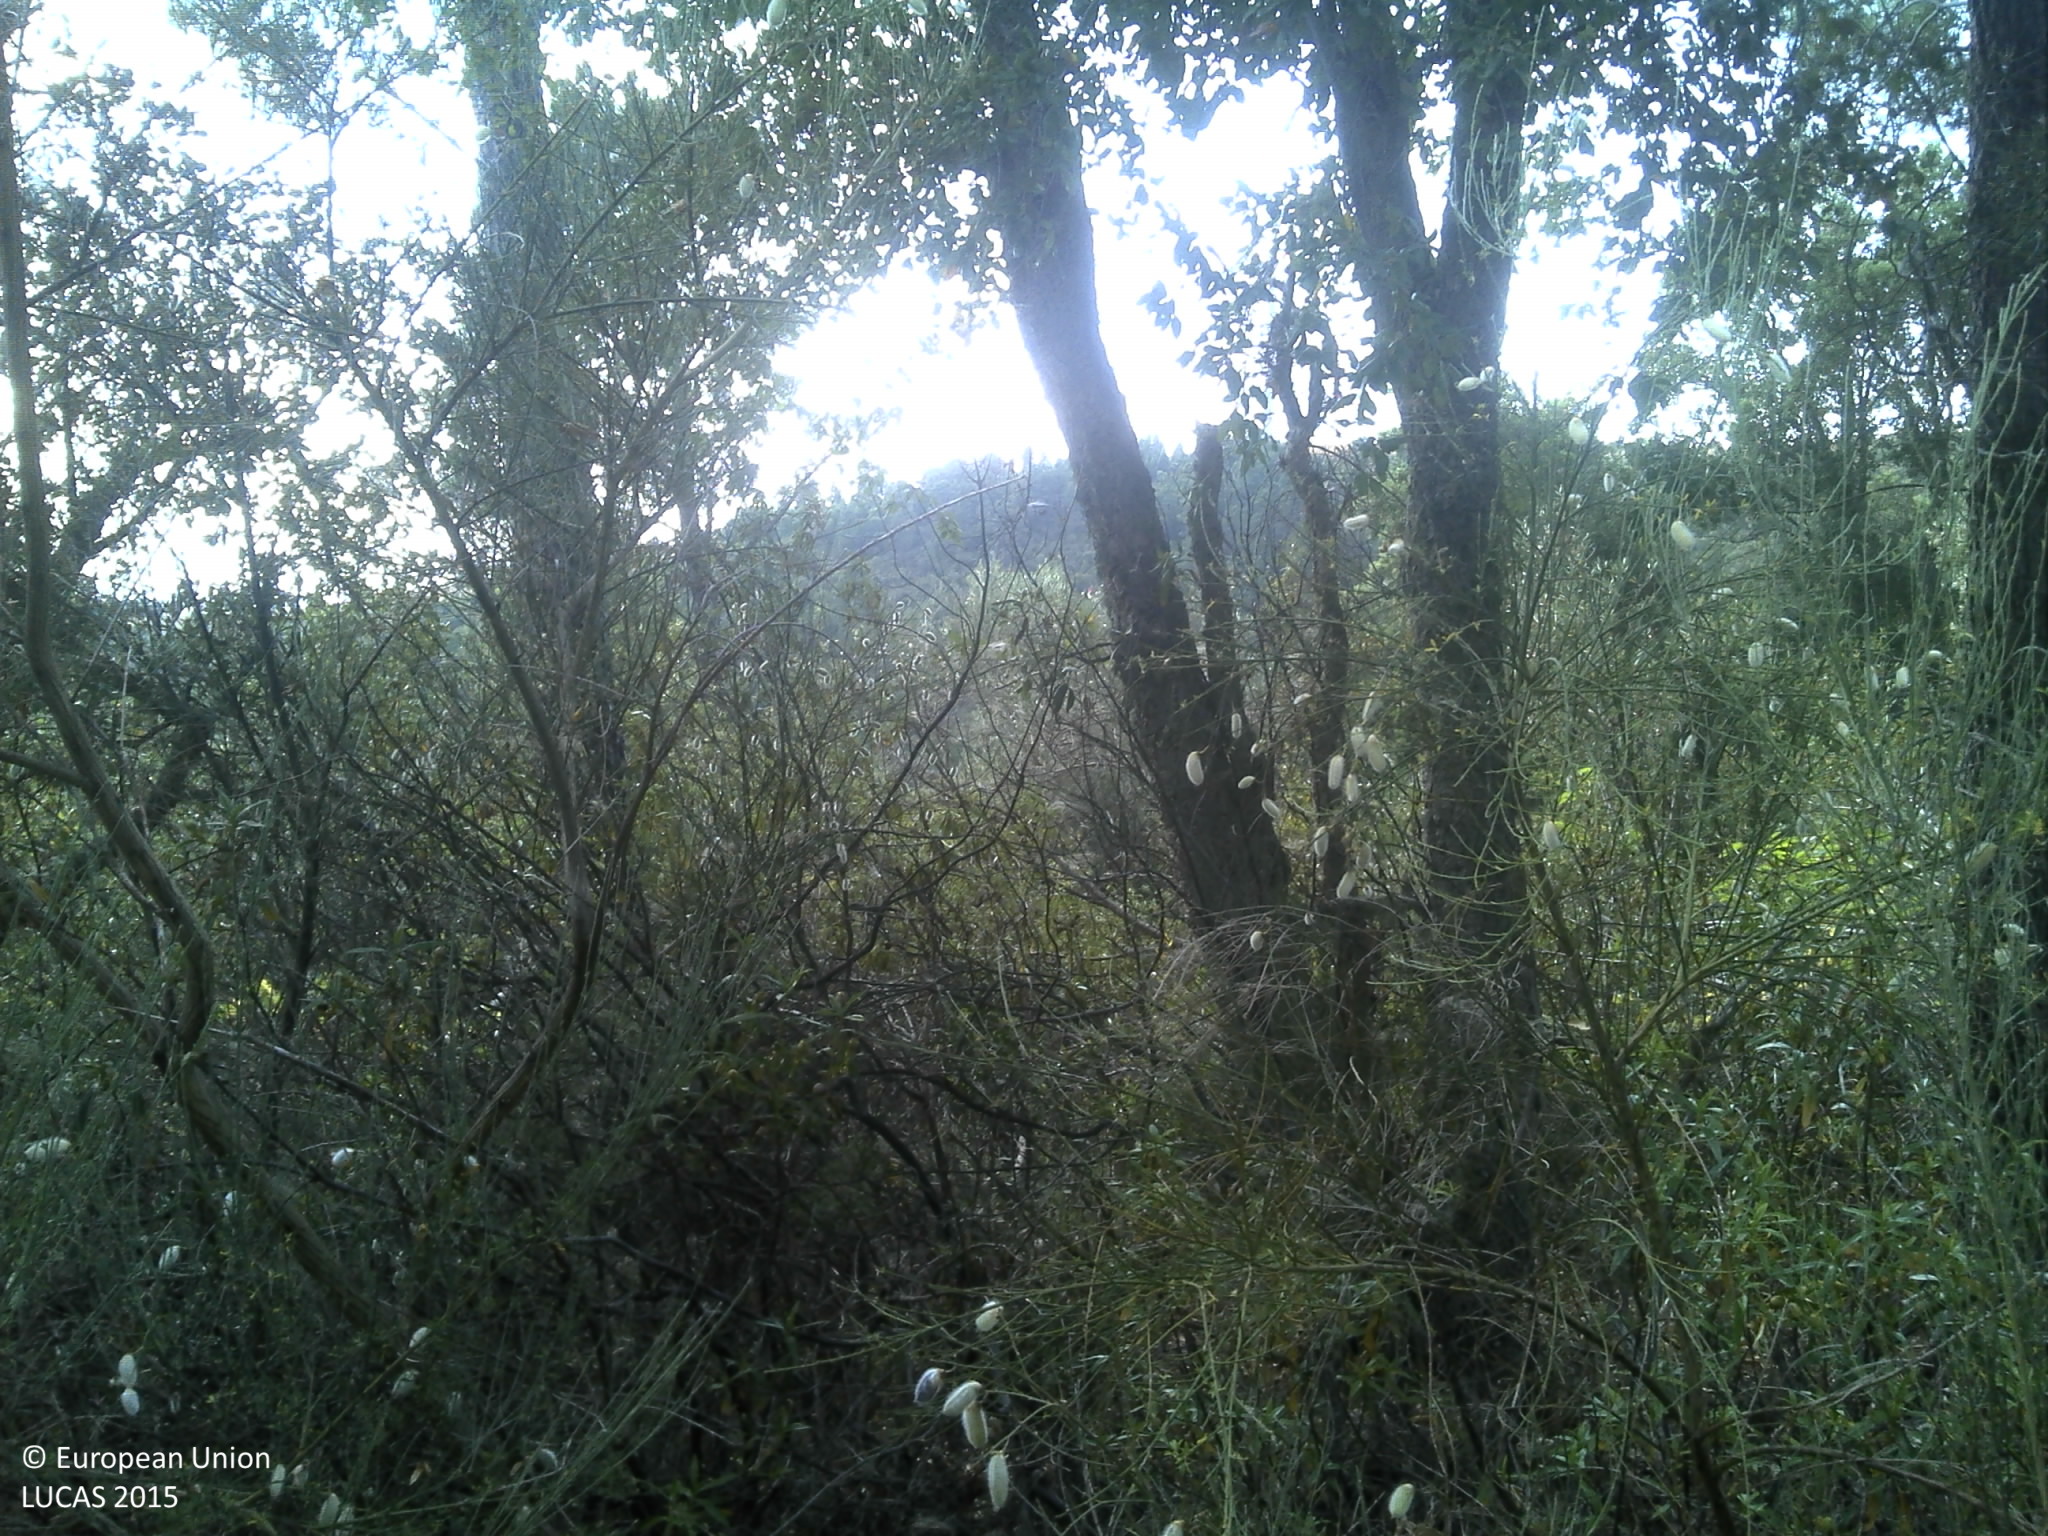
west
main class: Shrubland
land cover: Shrubland with sparse tree cover
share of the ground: 50 - 75 %
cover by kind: shrubs 75 %, unconsolidated bare surface 10 %, coniferous forest trees 5 %
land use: Forestry
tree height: > 5 m
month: June
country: PT
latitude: 40.2770
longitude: -7.1400
